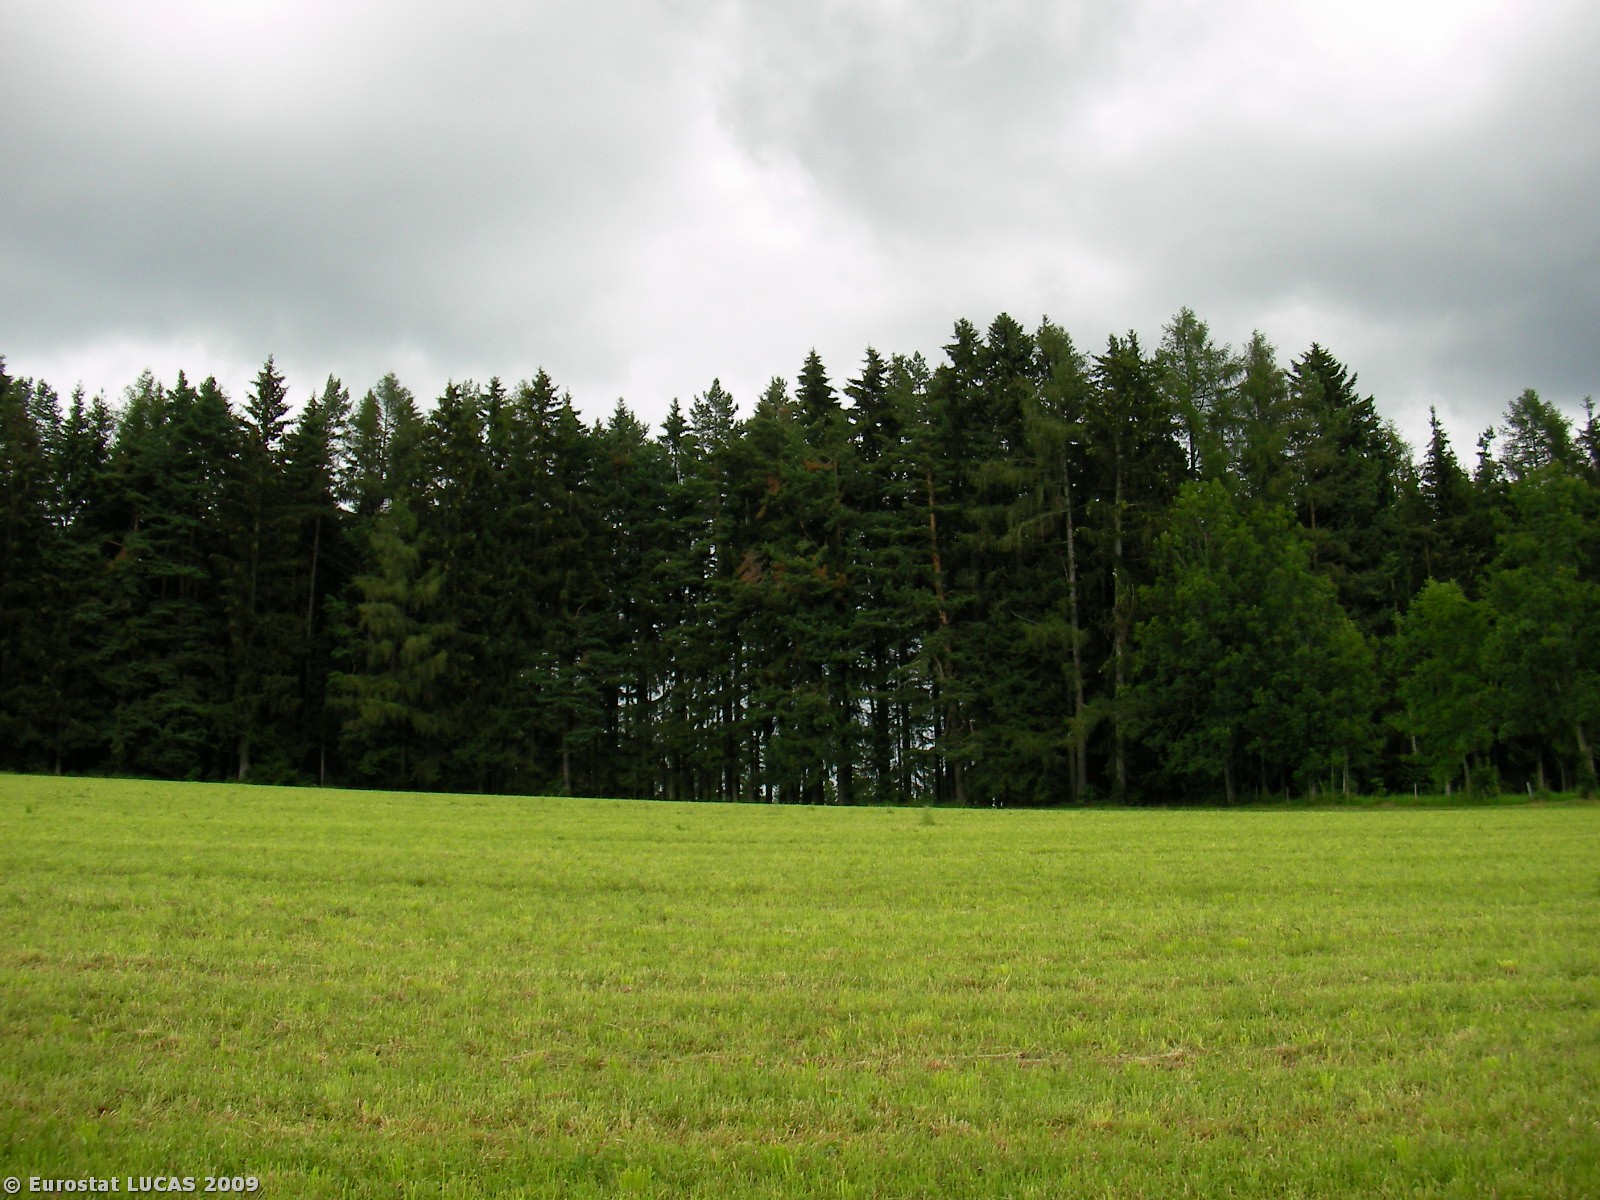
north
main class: Grassland
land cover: Grassland without tree/shrub cover
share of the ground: > 75 %
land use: Agriculture (excluding fallow land and kitchen gardens)
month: July
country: AT
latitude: 47.4299
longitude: 15.6356
